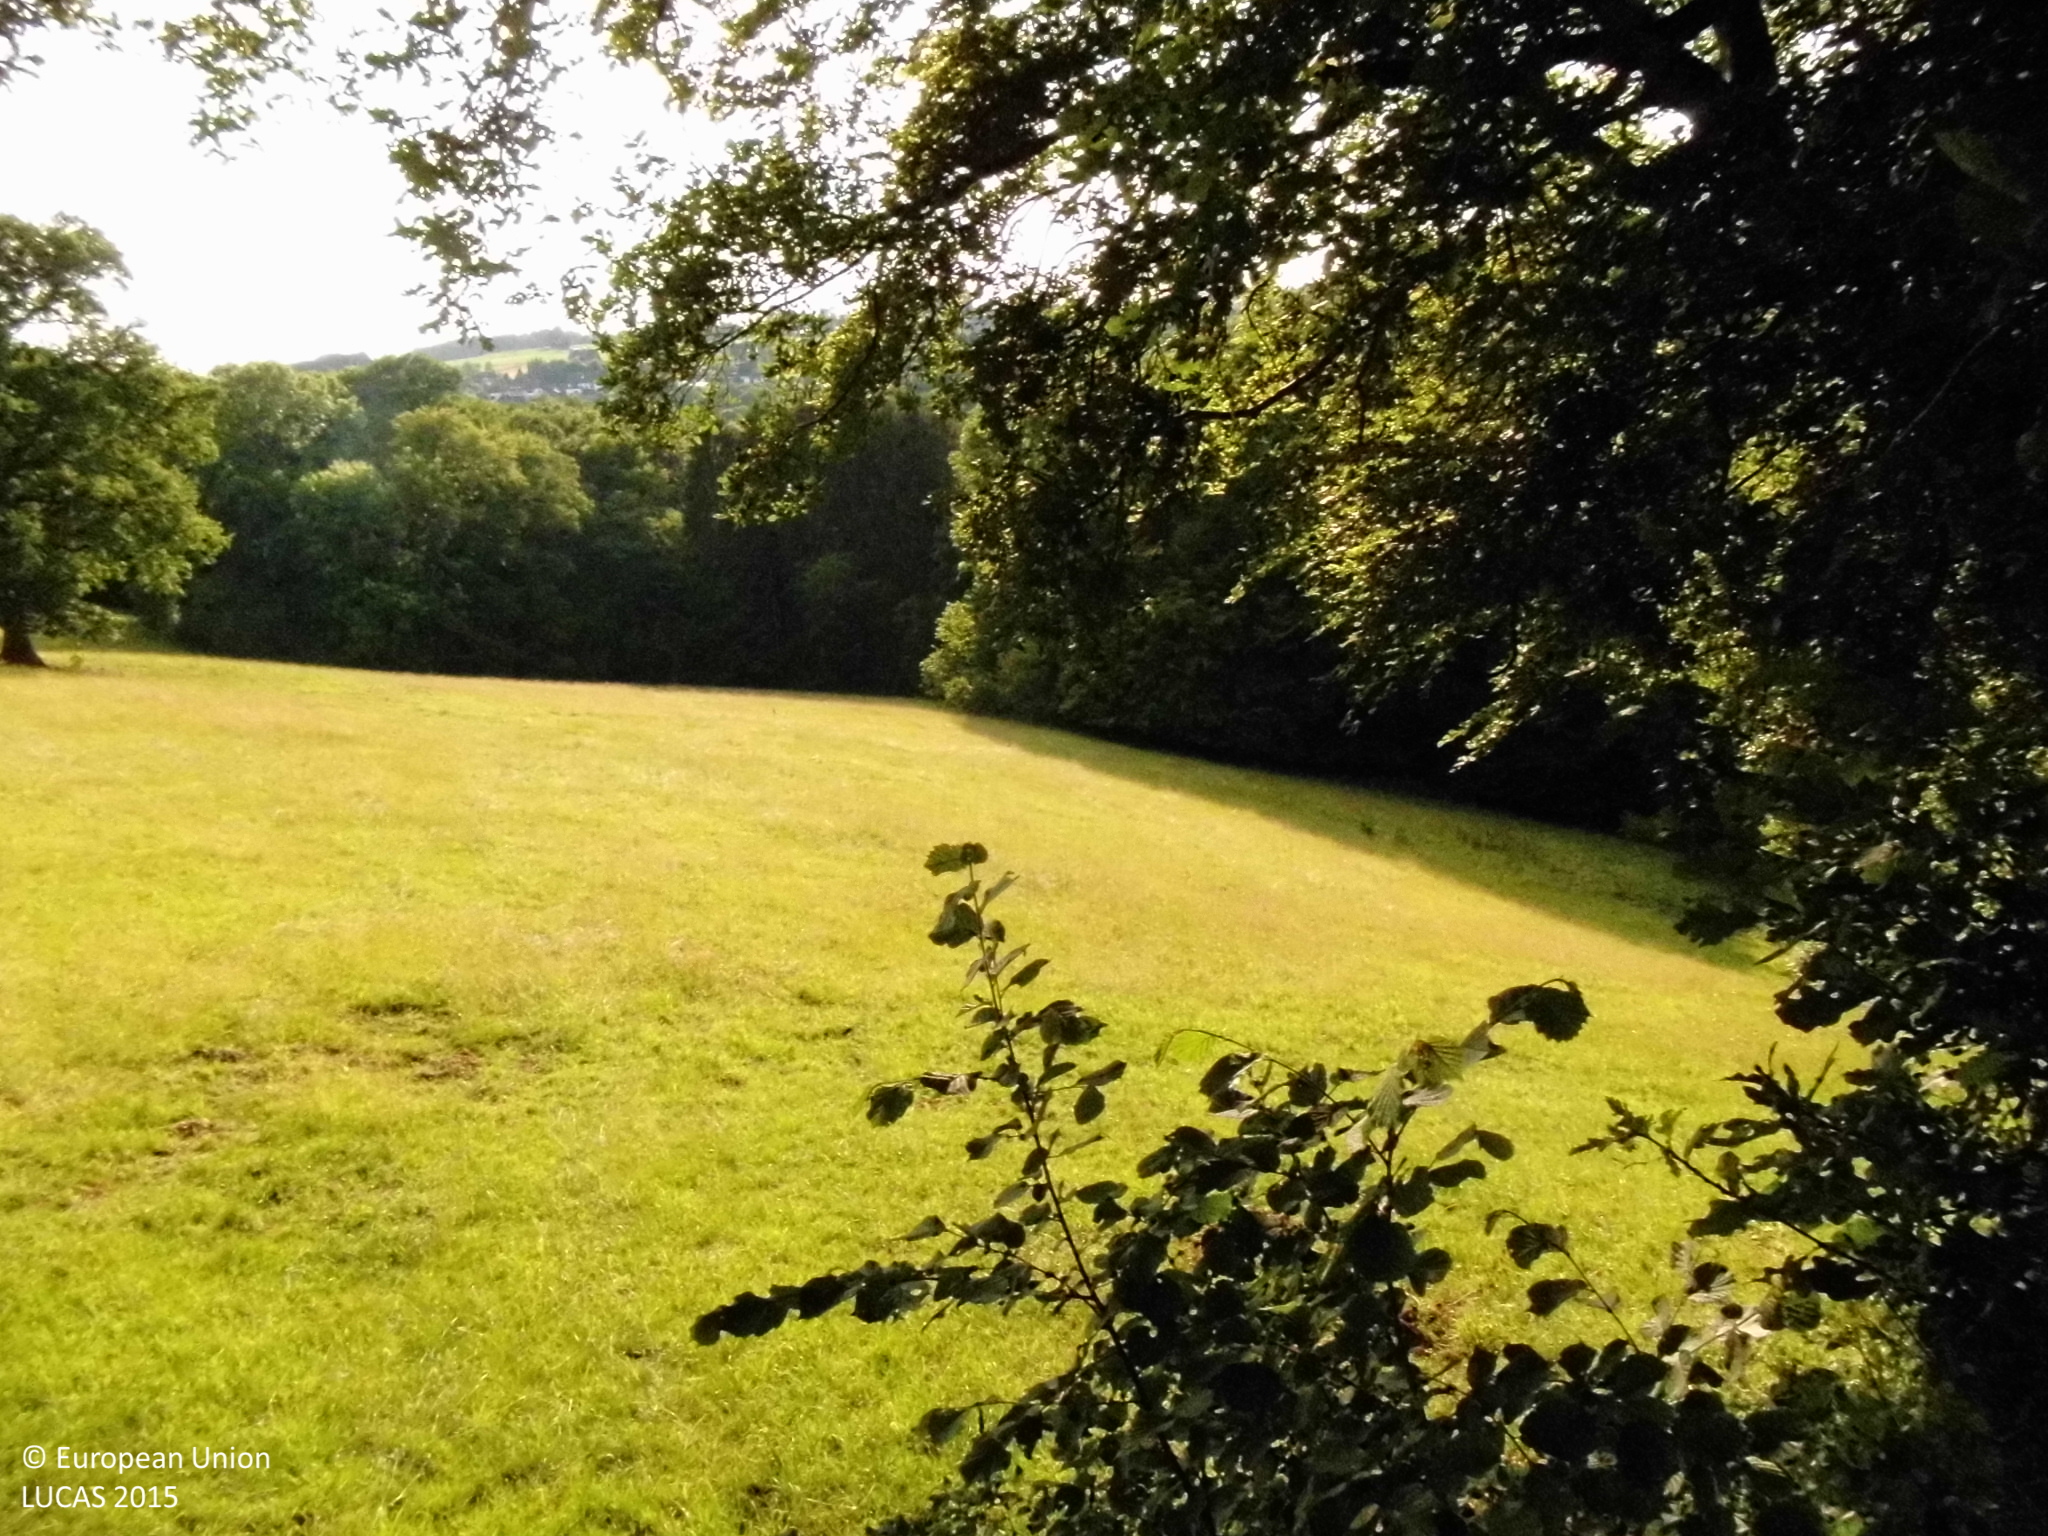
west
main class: Grassland
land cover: Grassland without tree/shrub cover
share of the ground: > 75 %
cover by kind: herbaceous plants 100 %
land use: Agriculture (excluding fallow land and kitchen gardens)
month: June
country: DE
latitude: 50.7856
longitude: 7.4612
